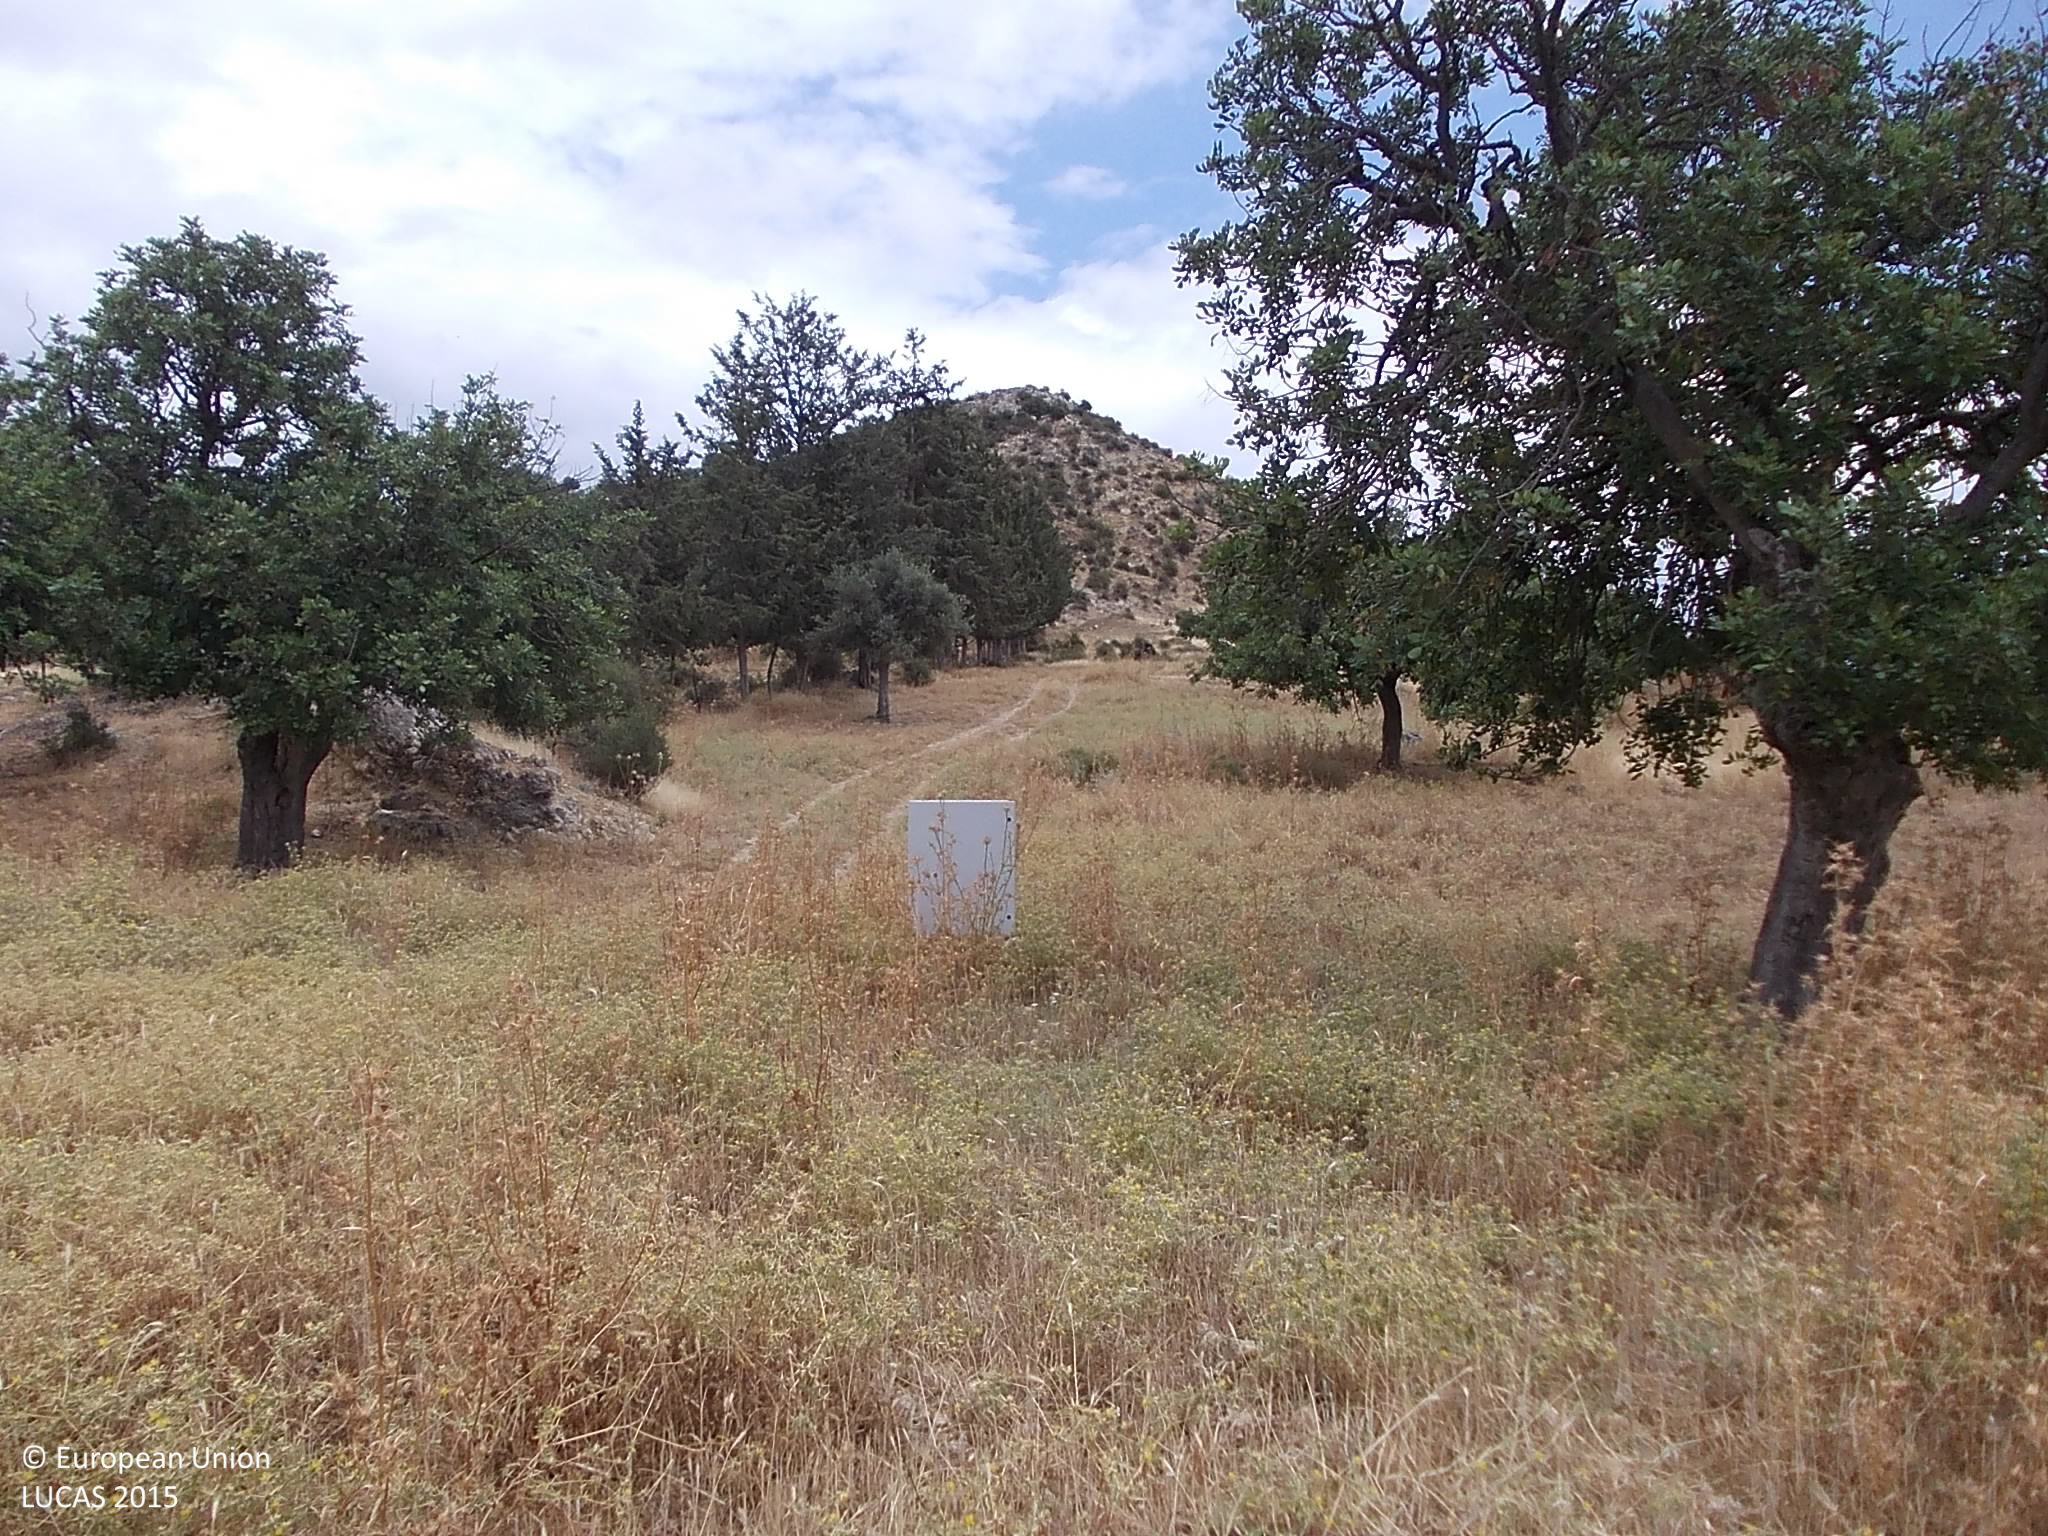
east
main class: Cropland
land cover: Permanent industrial crops
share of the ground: 10 - 25 %
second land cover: Spontaneously vegetated surfaces
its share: > 75 %
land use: Agriculture (excluding fallow land and kitchen gardens)
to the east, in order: Permanent industrial crops; Spontaneously vegetated surfaces; Shrubland without tree cover; Lines of trees; Fences; Shrubland with sparse tree cover; Dry stone walls; Grassland without tree/shrub cover; Single bushes/trees; Tracks; Shrubland without tree cover
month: May
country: CY
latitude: 34.7037
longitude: 32.7652
